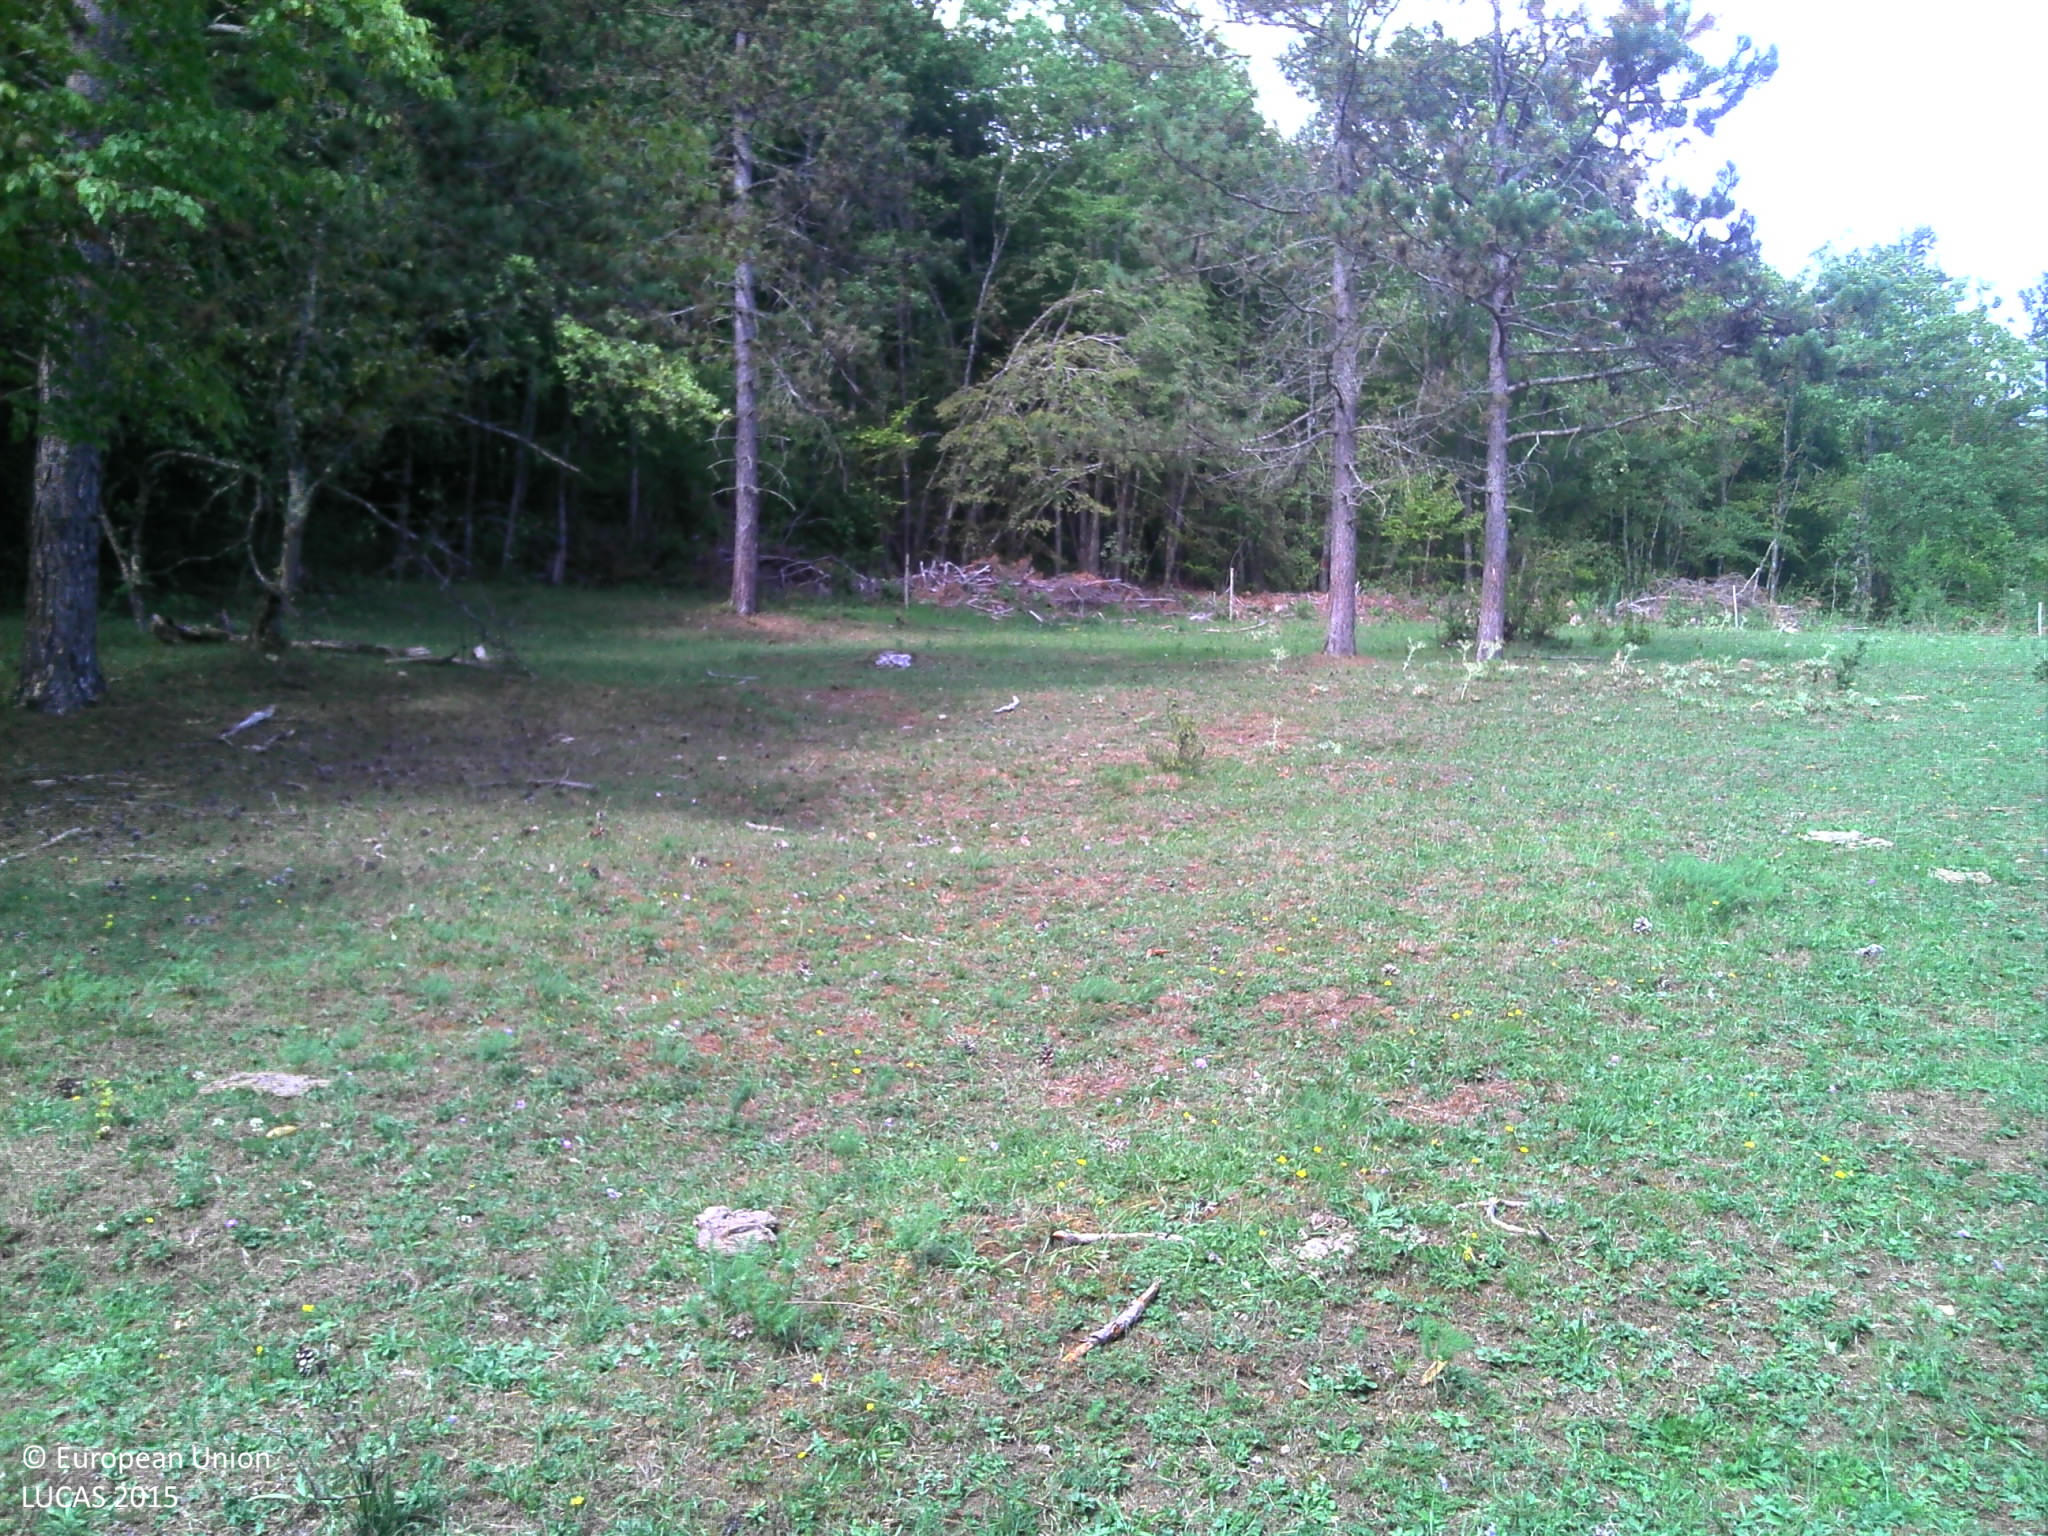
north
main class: Grassland
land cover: Grassland without tree/shrub cover
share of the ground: > 75 %
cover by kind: herbaceous plants 100 %
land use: Agriculture (excluding fallow land and kitchen gardens)
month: August
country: FR
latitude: 47.2318
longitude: 4.7300
